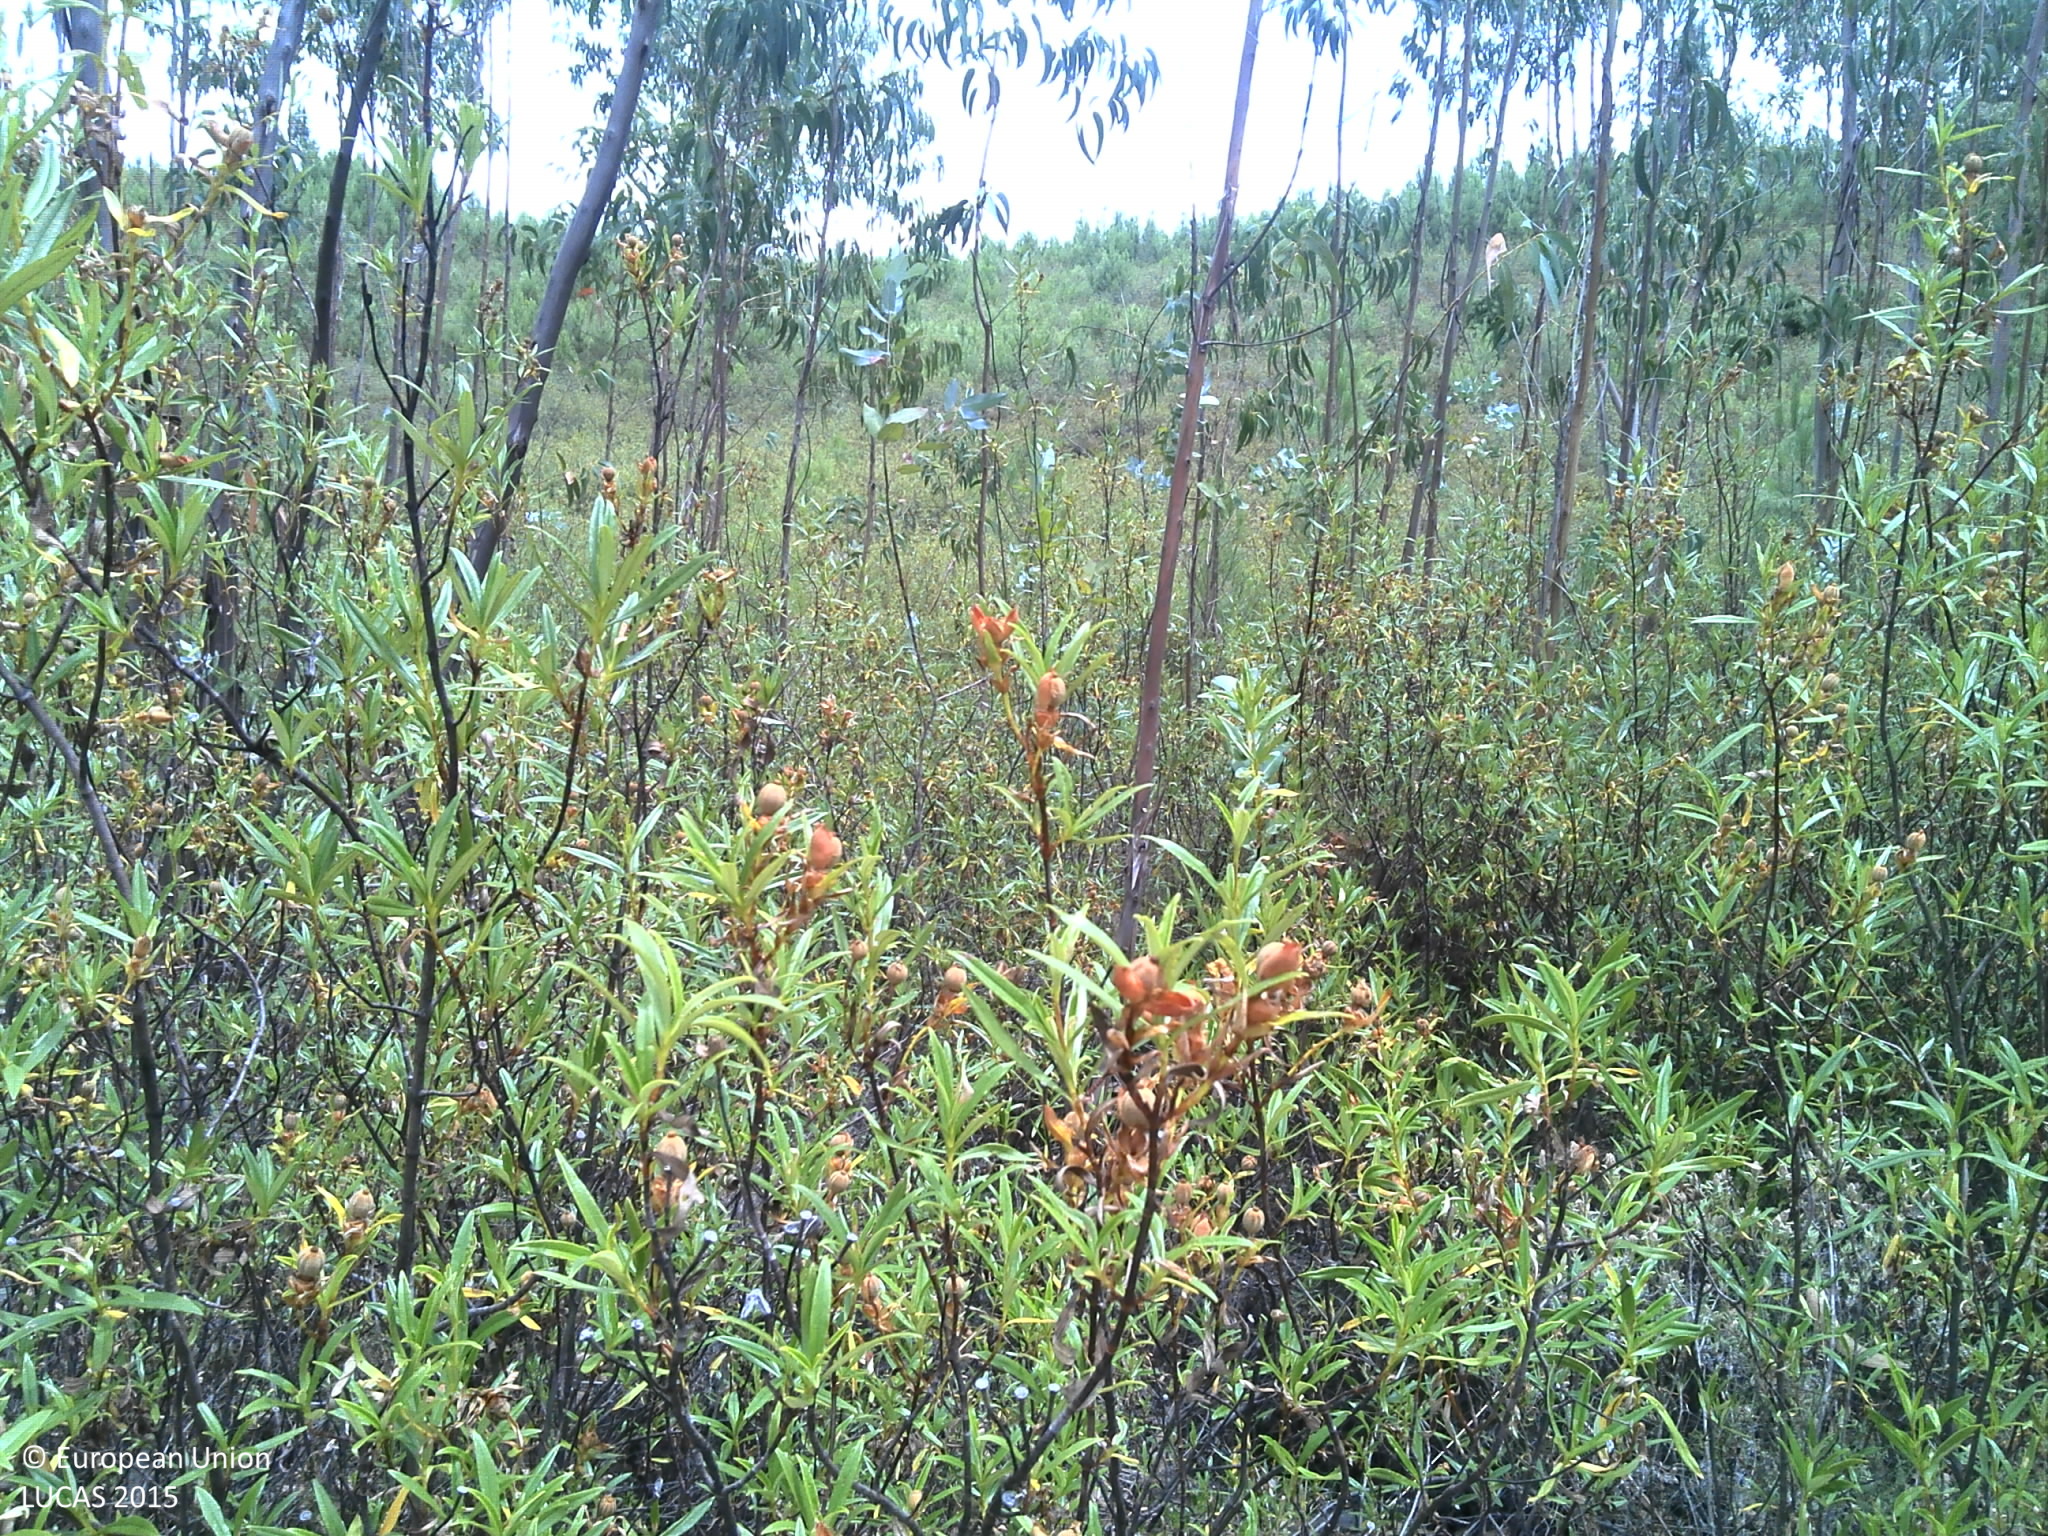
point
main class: Shrubland
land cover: Shrubland with sparse tree cover
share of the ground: > 75 %
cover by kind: shrubs 85 %, broadleaved forest trees 5 %, consolidated bare surface 5 %, unconsolidated bare surface 5 %
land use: Abandoned areas
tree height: > 5 m
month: July
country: PT
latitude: 39.5674
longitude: -8.0935
